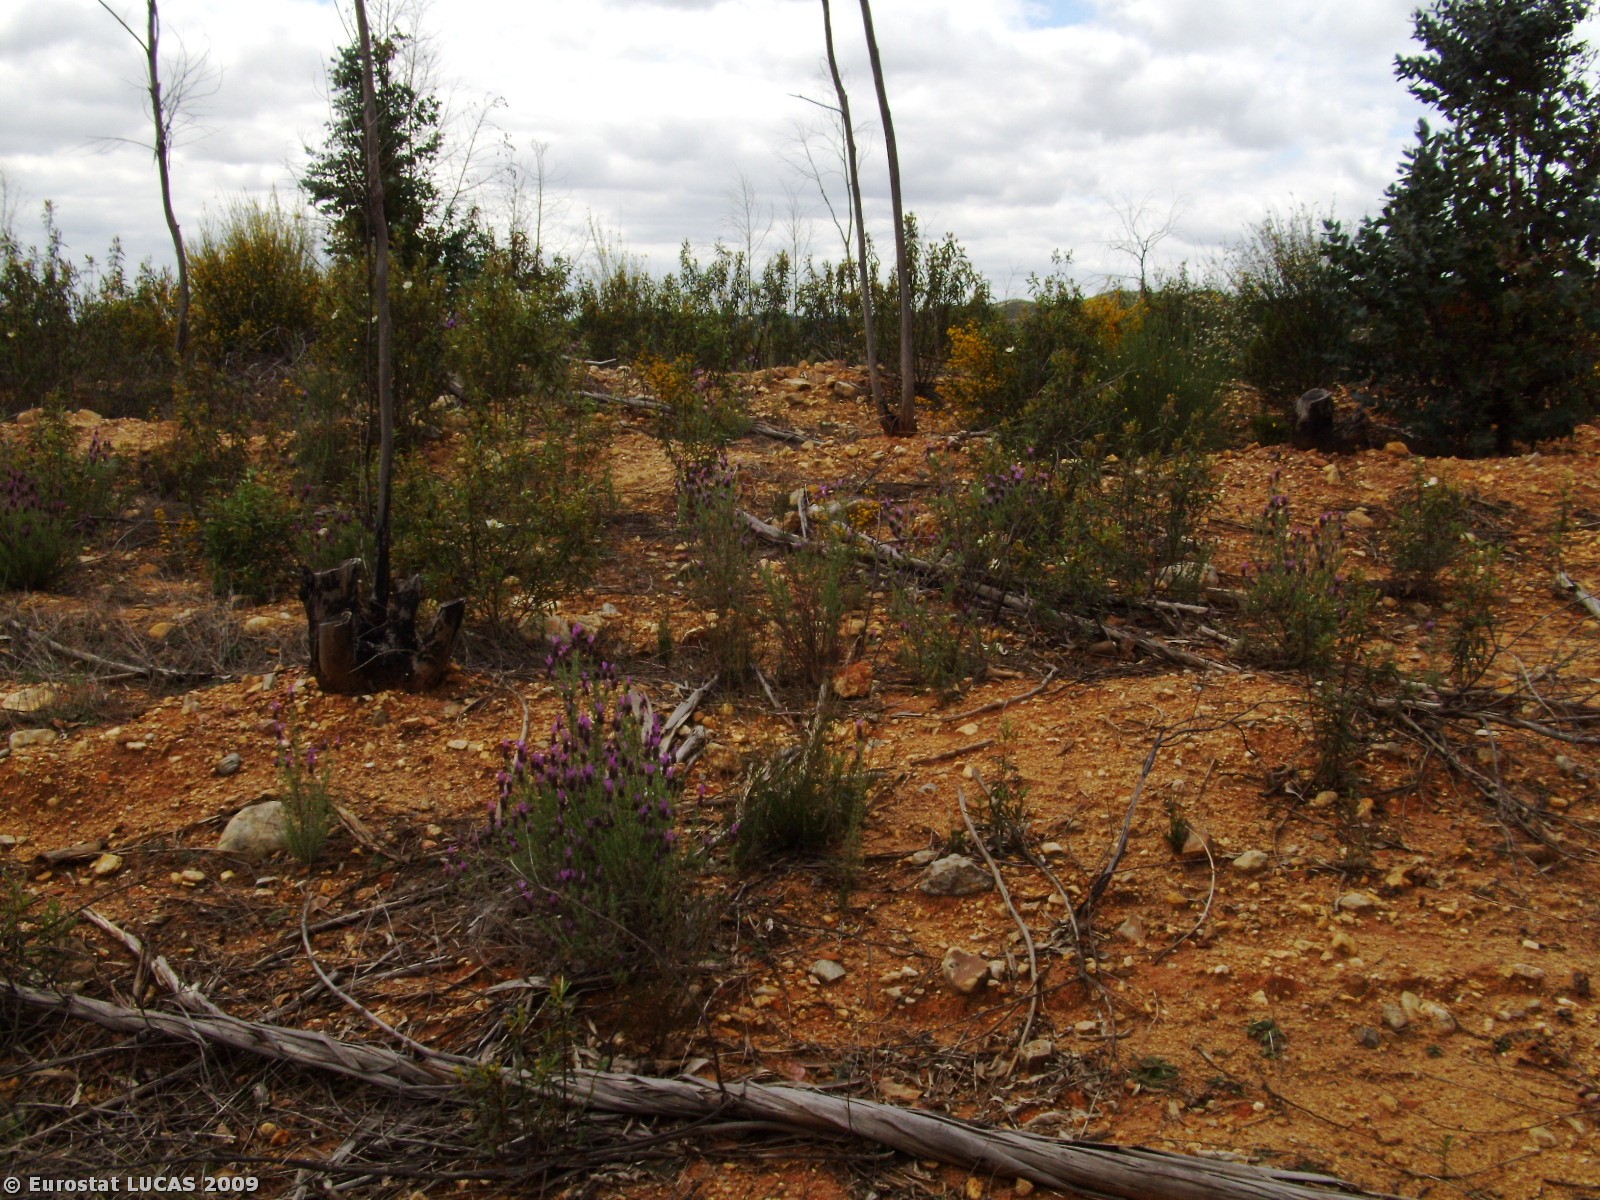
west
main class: Woodland
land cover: Broadleaved woodland
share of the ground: > 75 %
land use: Forestry
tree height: > 5 m
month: April
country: PT
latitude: 39.7814
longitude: -7.4359
